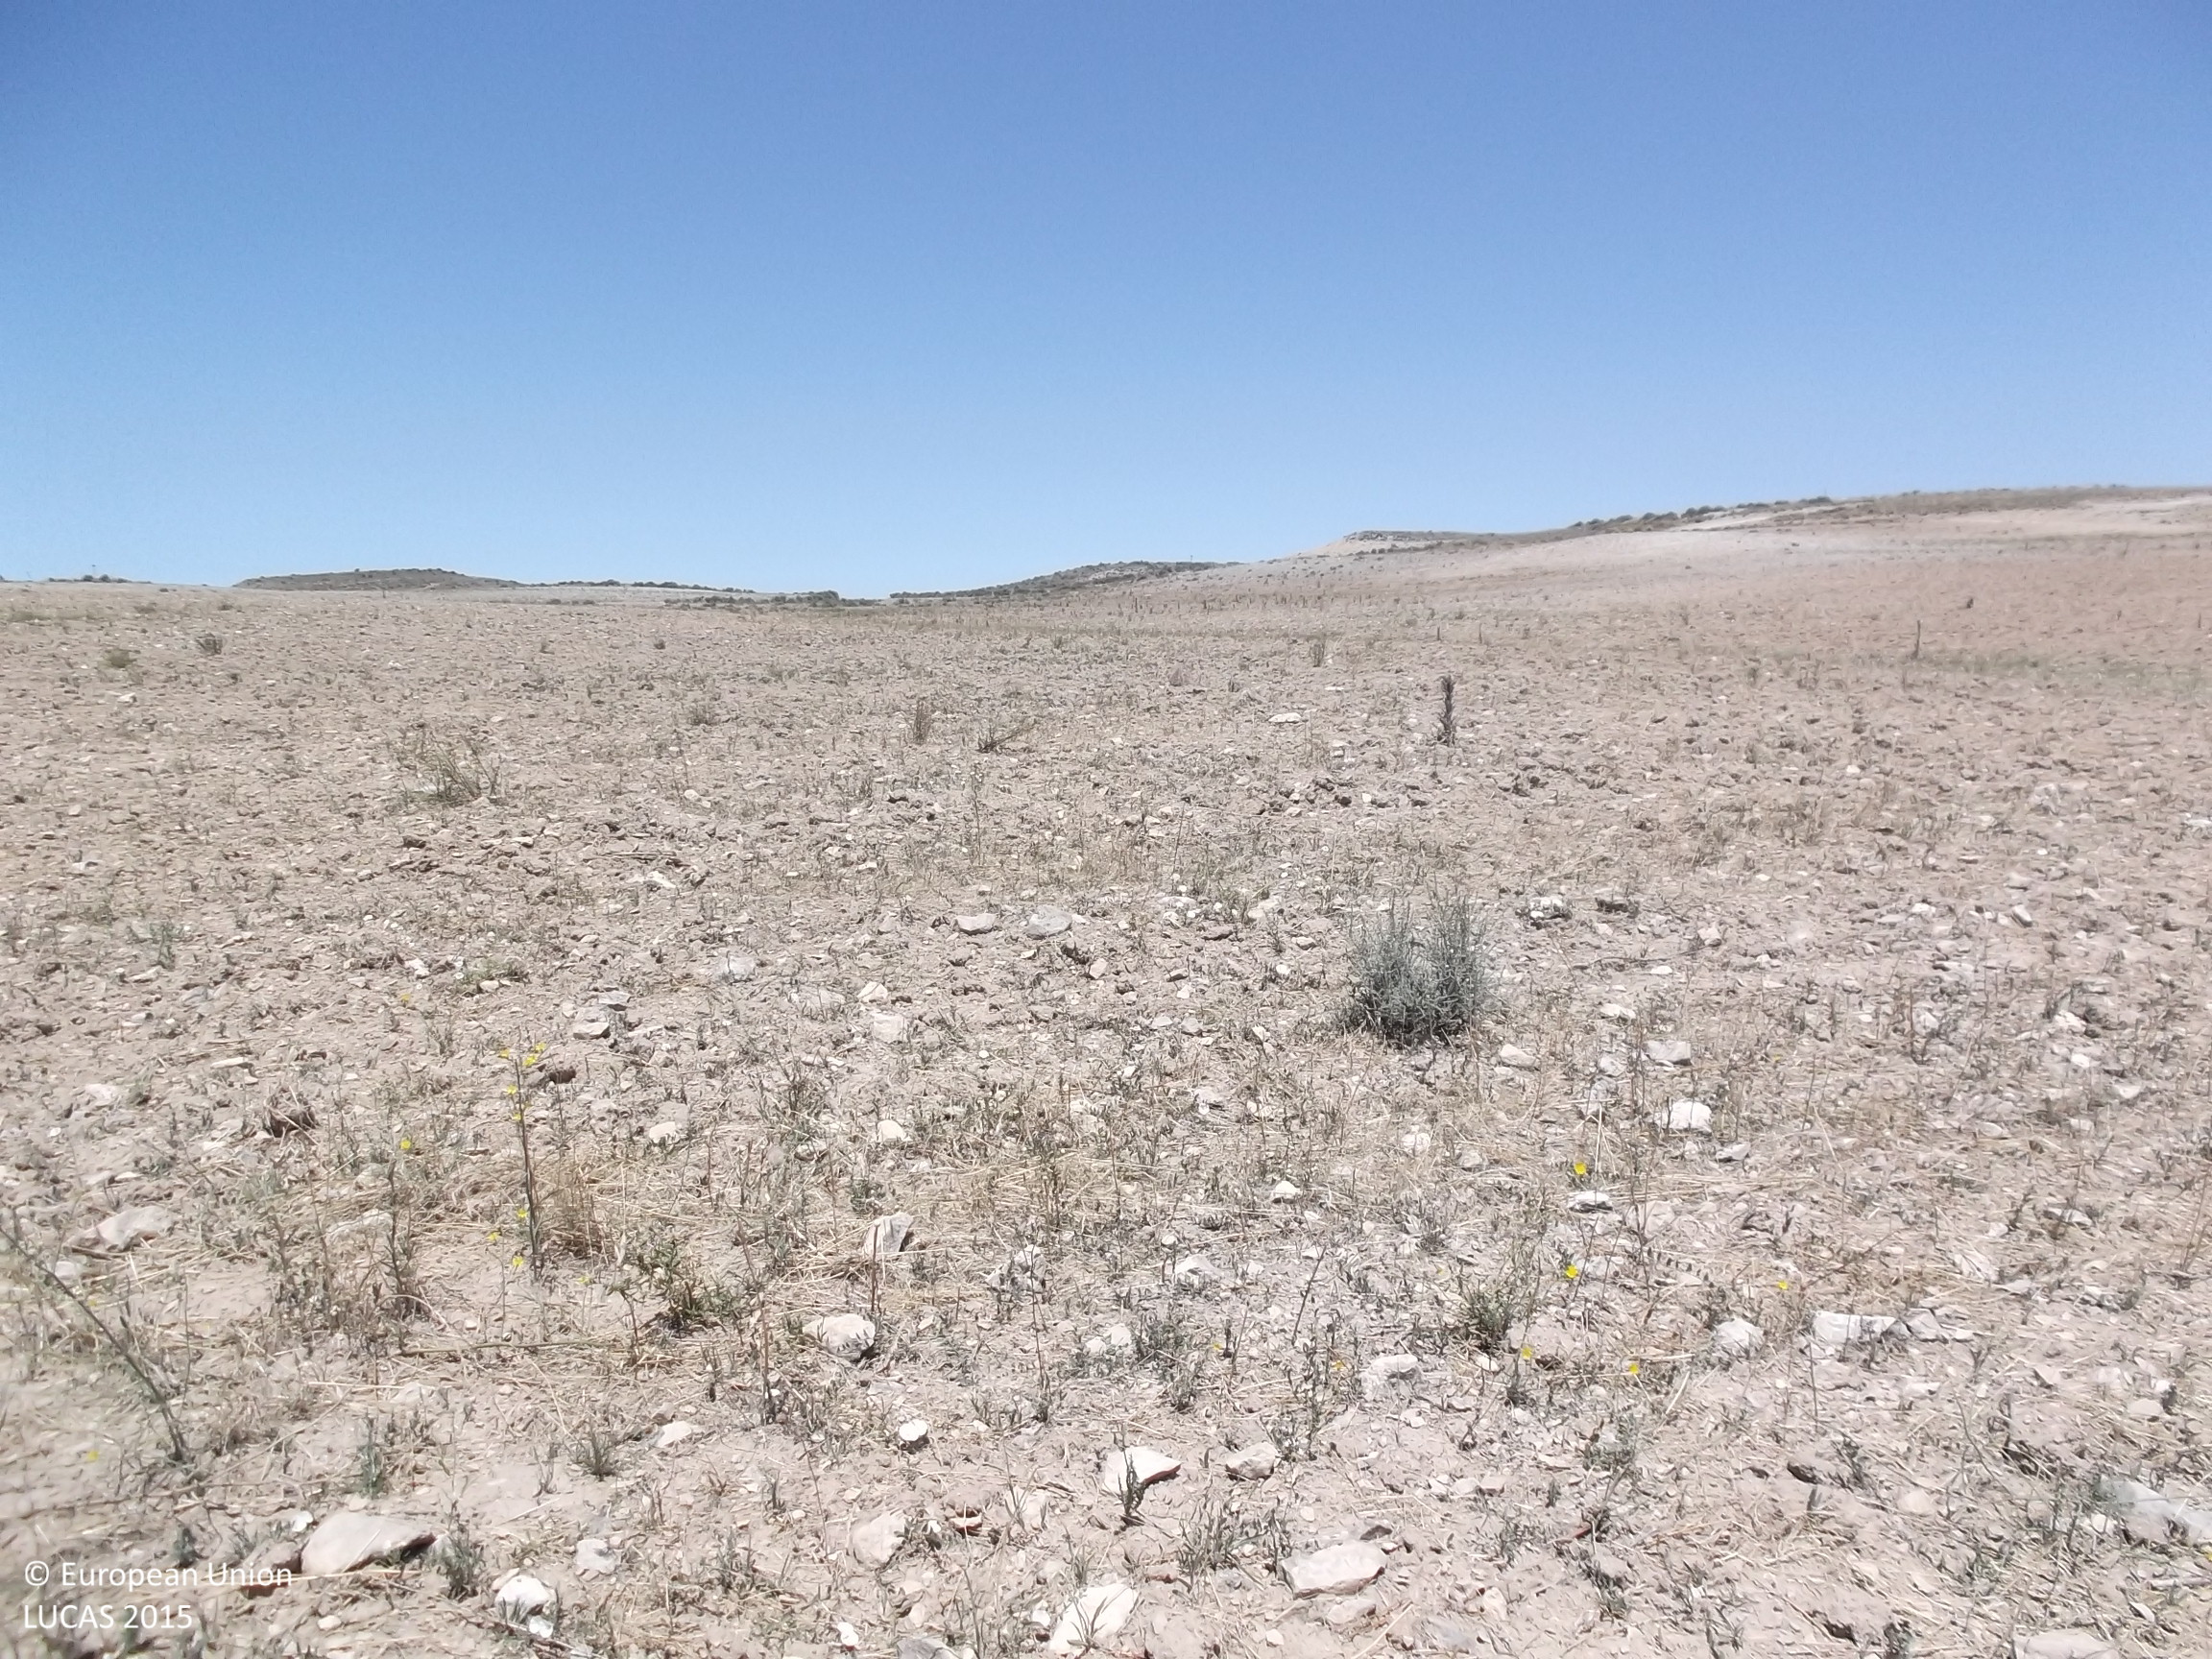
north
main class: Grassland
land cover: Spontaneously vegetated surfaces
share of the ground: 10 - 25 %
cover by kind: unconsolidated bare surface 75 %, herbaceous plants 20 %
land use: Fallow land
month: July
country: ES
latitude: 42.1203
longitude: -1.5346
